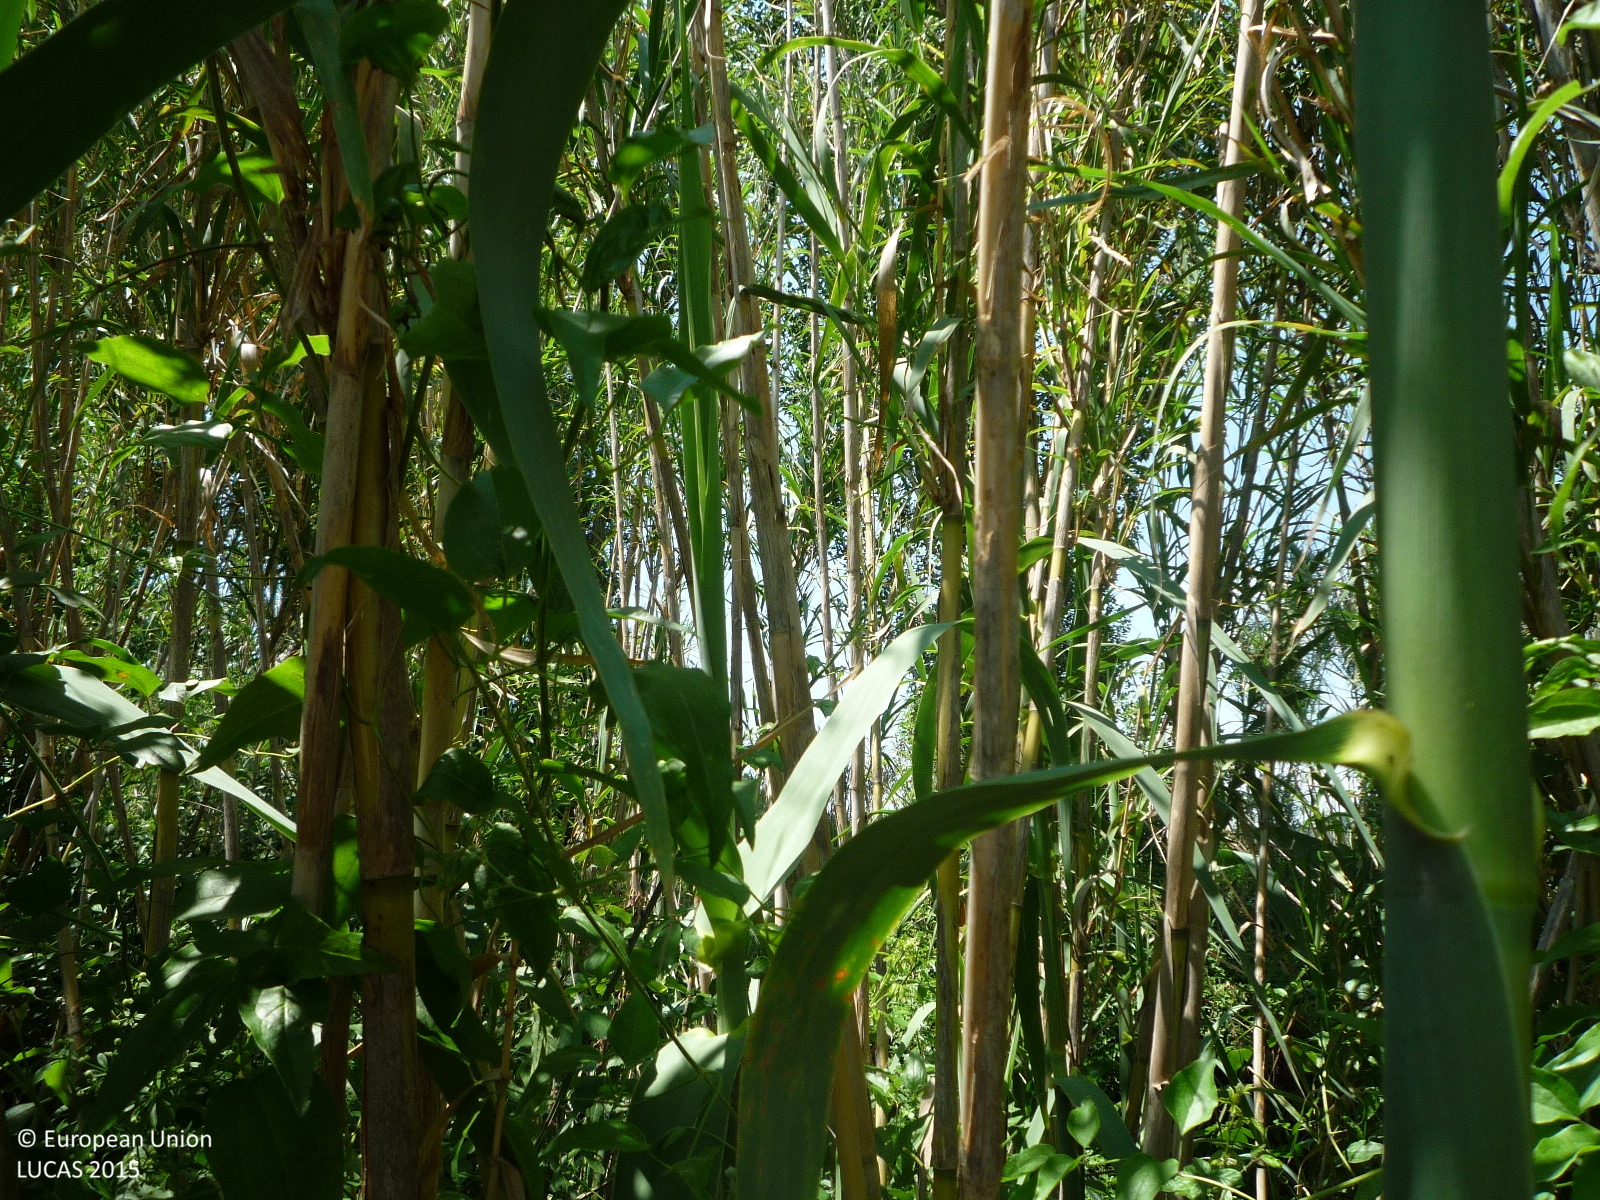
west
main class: Shrubland
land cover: Shrubland with sparse tree cover
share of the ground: > 75 %
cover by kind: shrubs 95 %, broadleaved forest trees 5 %
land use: Semi-natural and natural areas not in use
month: June
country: ES
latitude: 41.8080
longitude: 1.9625
